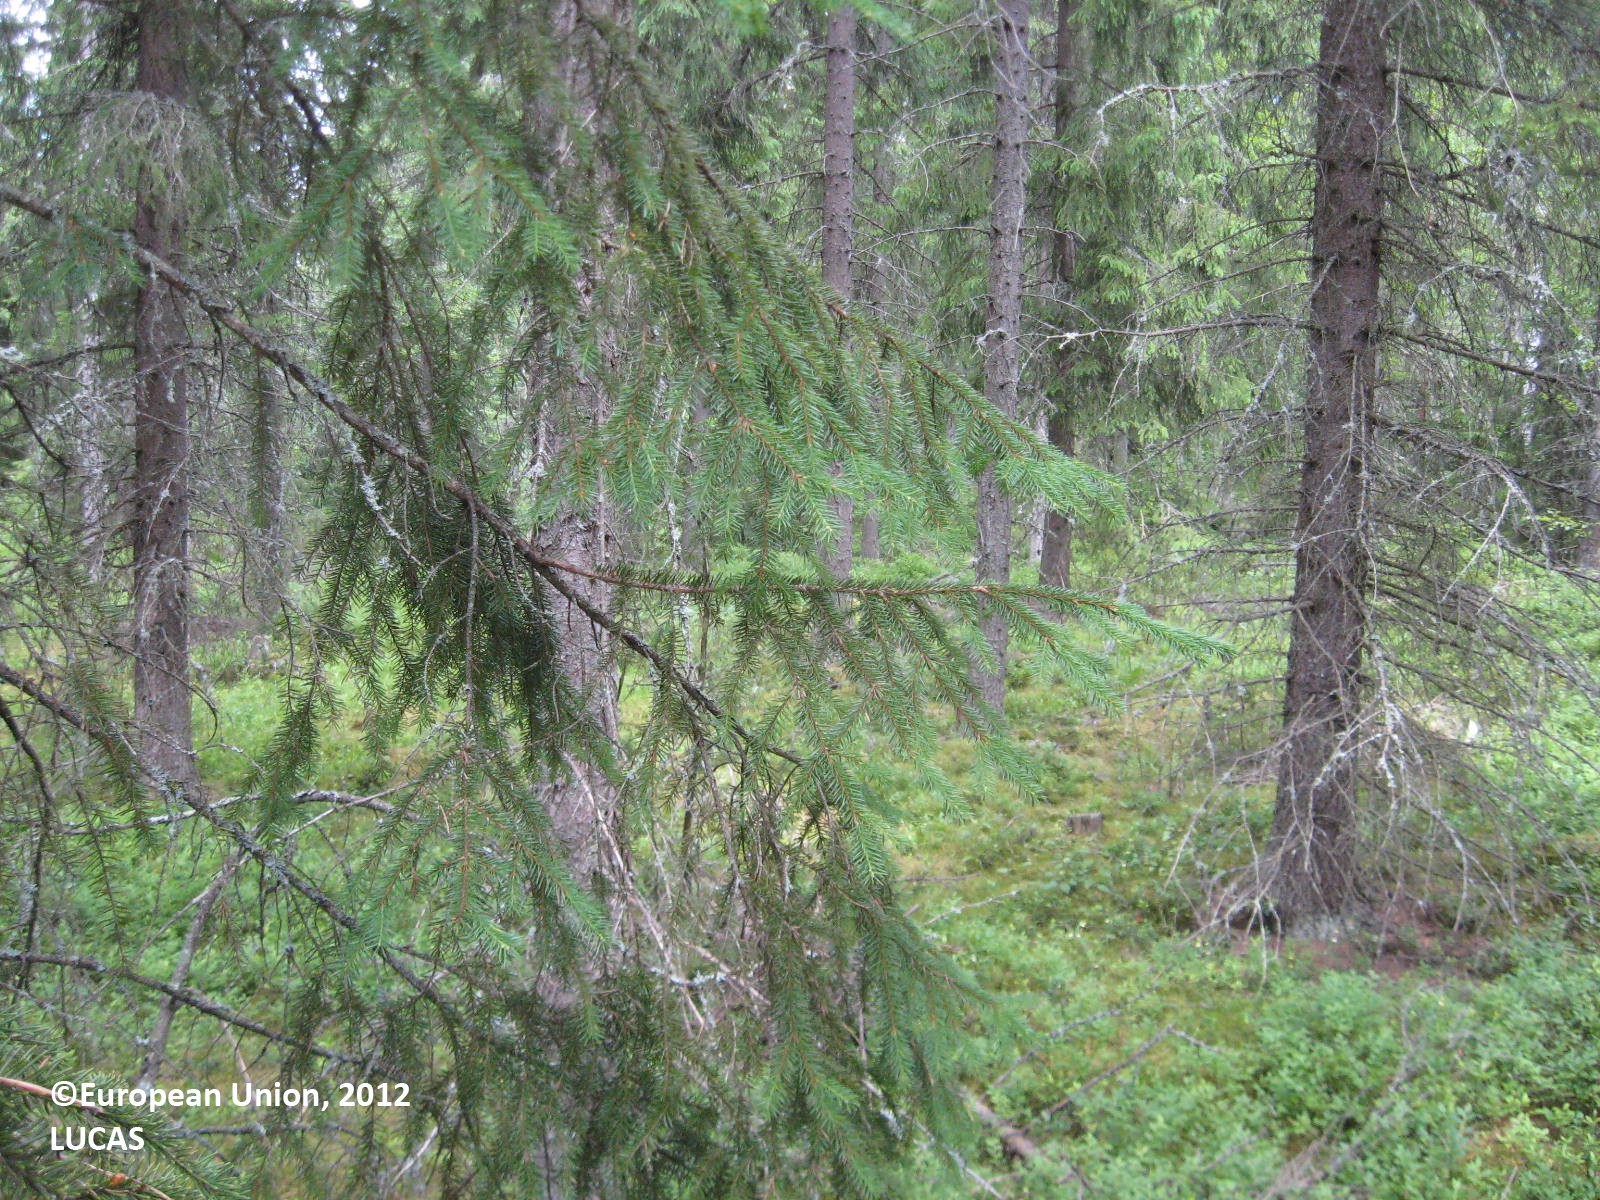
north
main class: Woodland
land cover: Other coniferous woodland
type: boreal forest
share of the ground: > 75 %
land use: Forestry
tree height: > 5 m
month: July
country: FI
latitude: 62.6576
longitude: 22.4856
